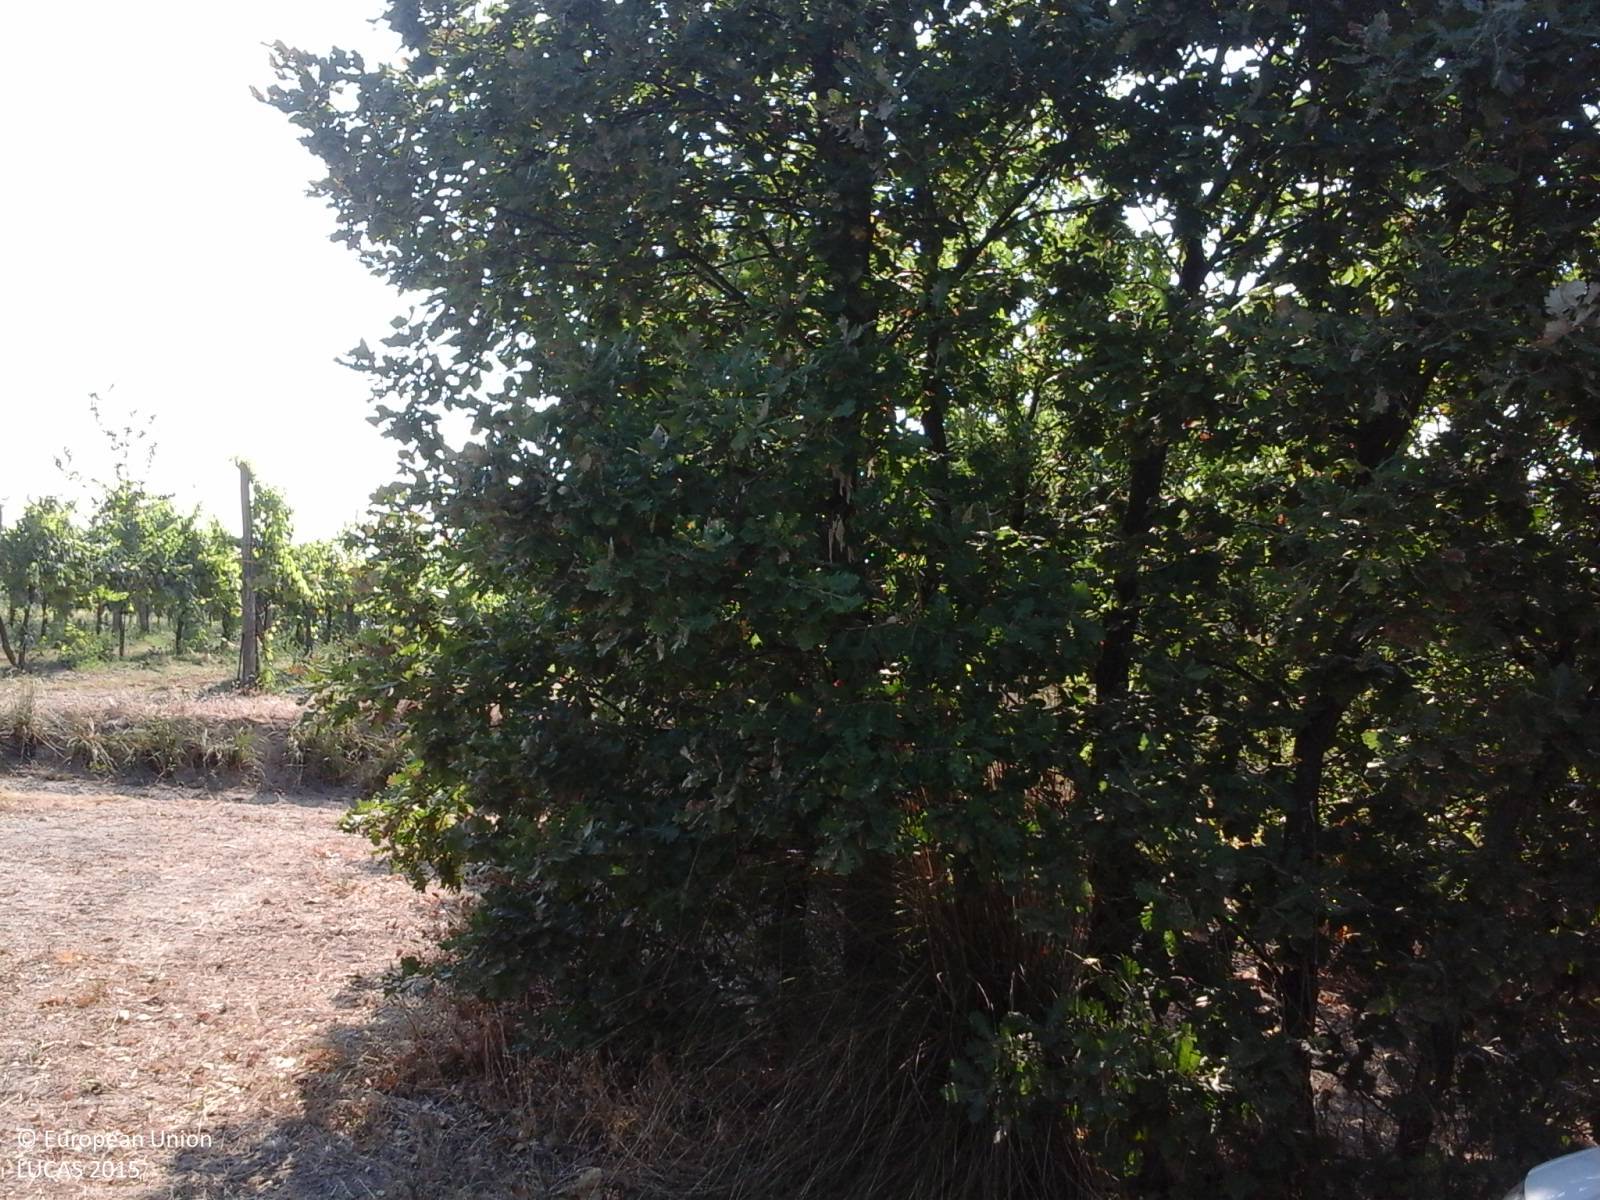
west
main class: Shrubland
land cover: Shrubland with sparse tree cover
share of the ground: 50 - 75 %
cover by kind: shrubs 95 %, broadleaved forest trees 5 %
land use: Abandoned areas
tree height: < 5 m
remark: Burnt area
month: July
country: IT
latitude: 41.2570
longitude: 13.9350
